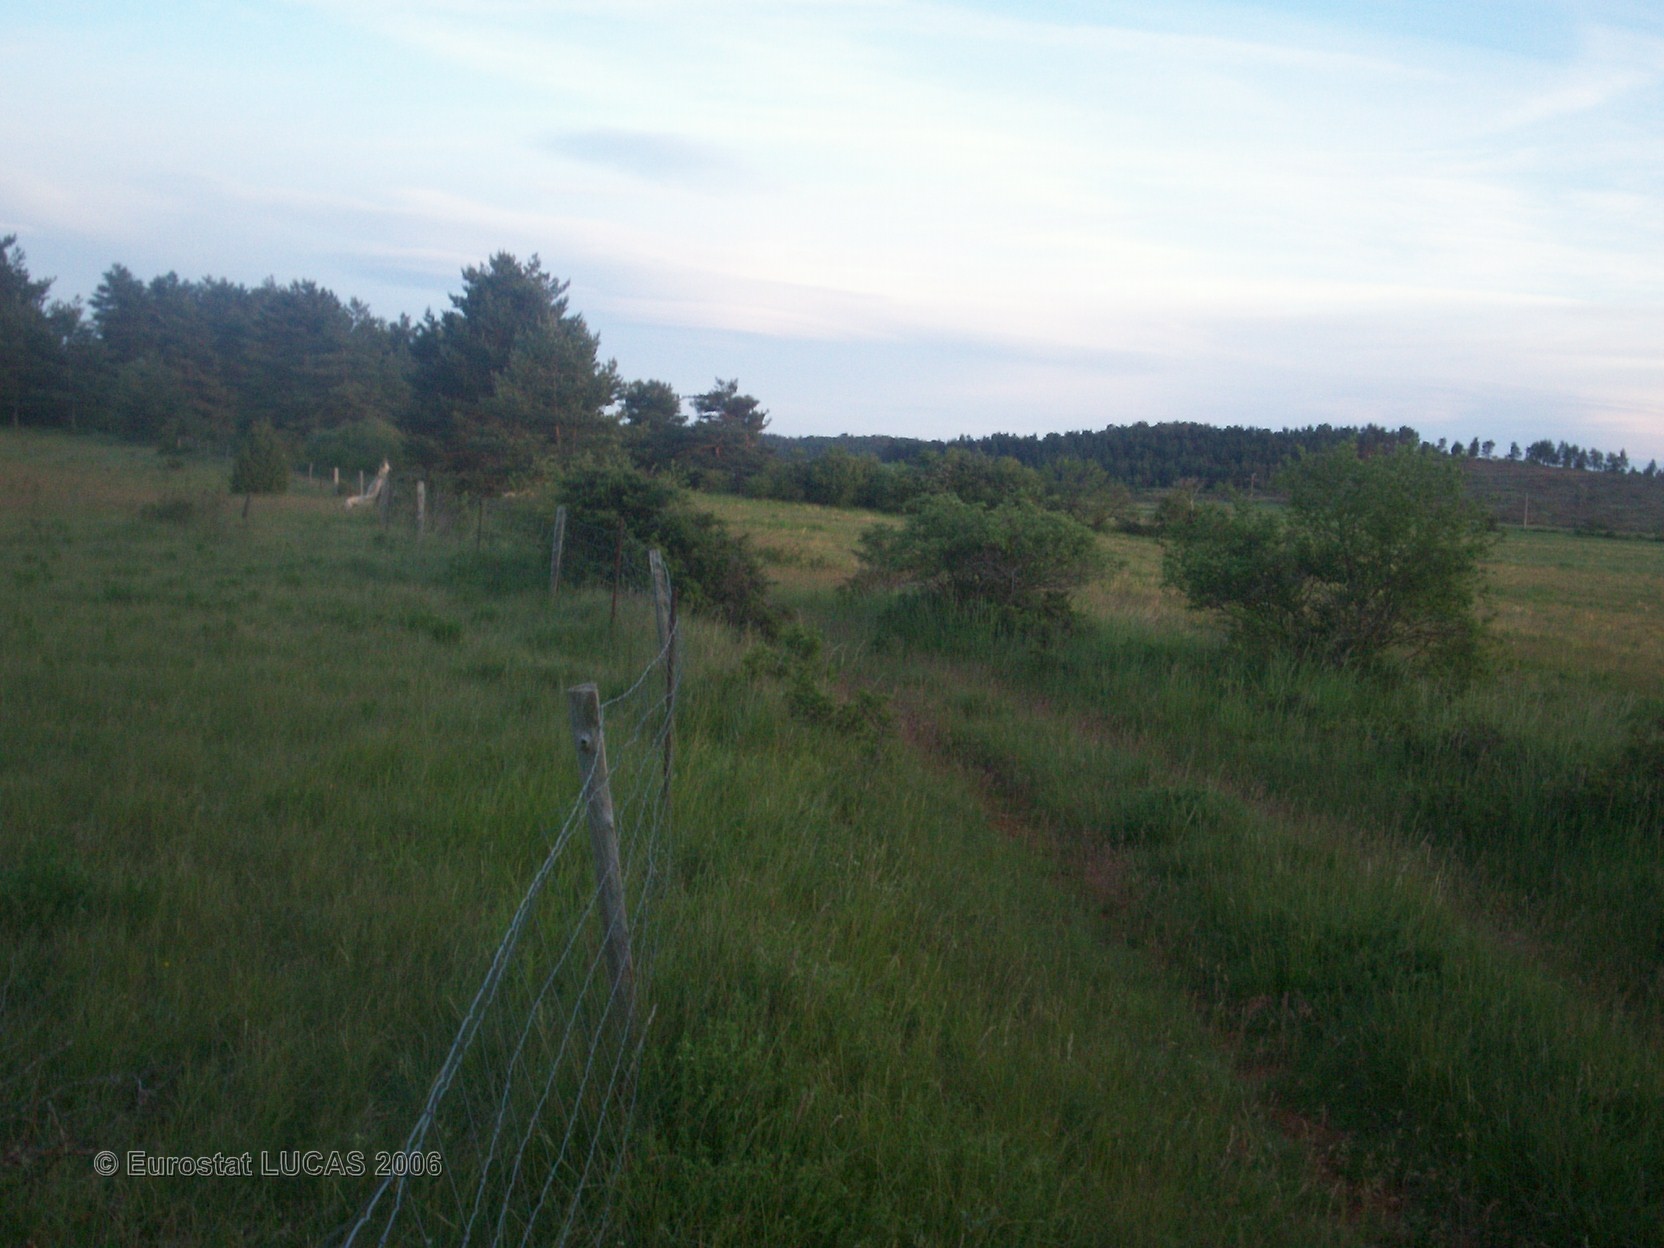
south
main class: Grassland
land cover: Grassland without tree/shrub cover
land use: Agriculture (excluding fallow land and kitchen gardens)
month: June
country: FR
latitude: 44.4484
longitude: 3.4082
